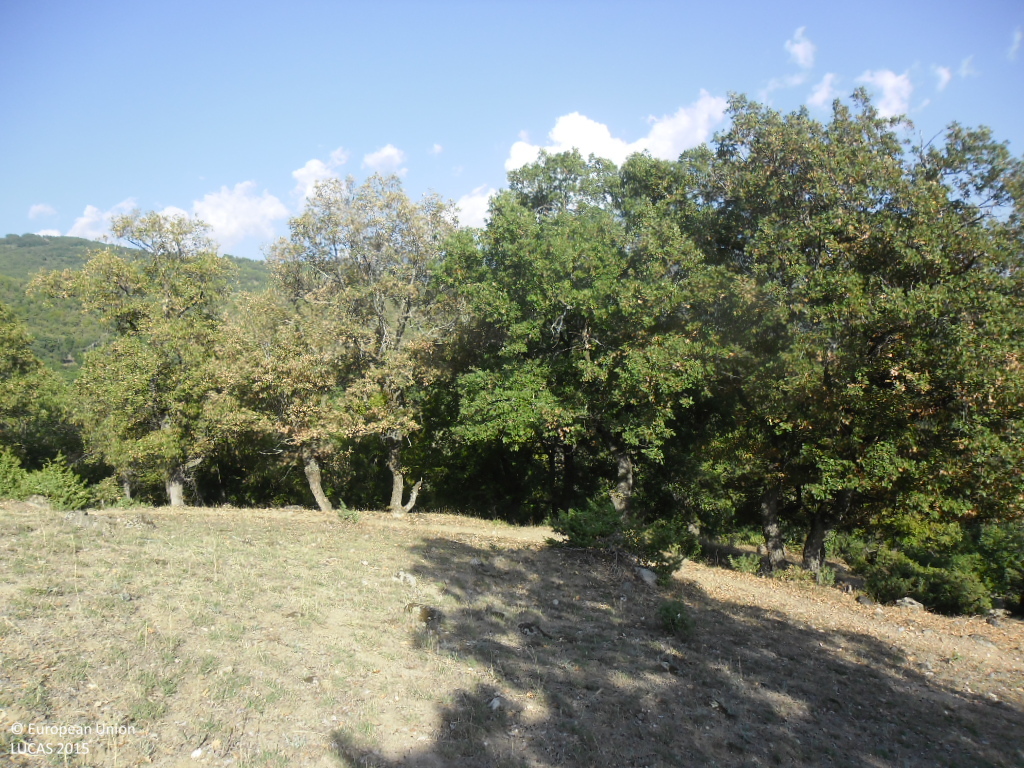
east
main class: Grassland
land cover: Grassland with sparse tree/shrub cover
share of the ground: > 75 %
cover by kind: herbaceous plants 90 %, broadleaved forest trees 5 %, shrubs 5 %
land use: Agriculture (excluding fallow land and kitchen gardens)
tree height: < 5 m
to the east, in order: Grassland with sparse tree/shrub cover; Broadleaved woodland; Grassland with sparse tree/shrub cover; Tracks; Grassland with sparse tree/shrub cover; Tracks; Broadleaved woodland
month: September
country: BG
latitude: 41.6250
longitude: 23.3098
